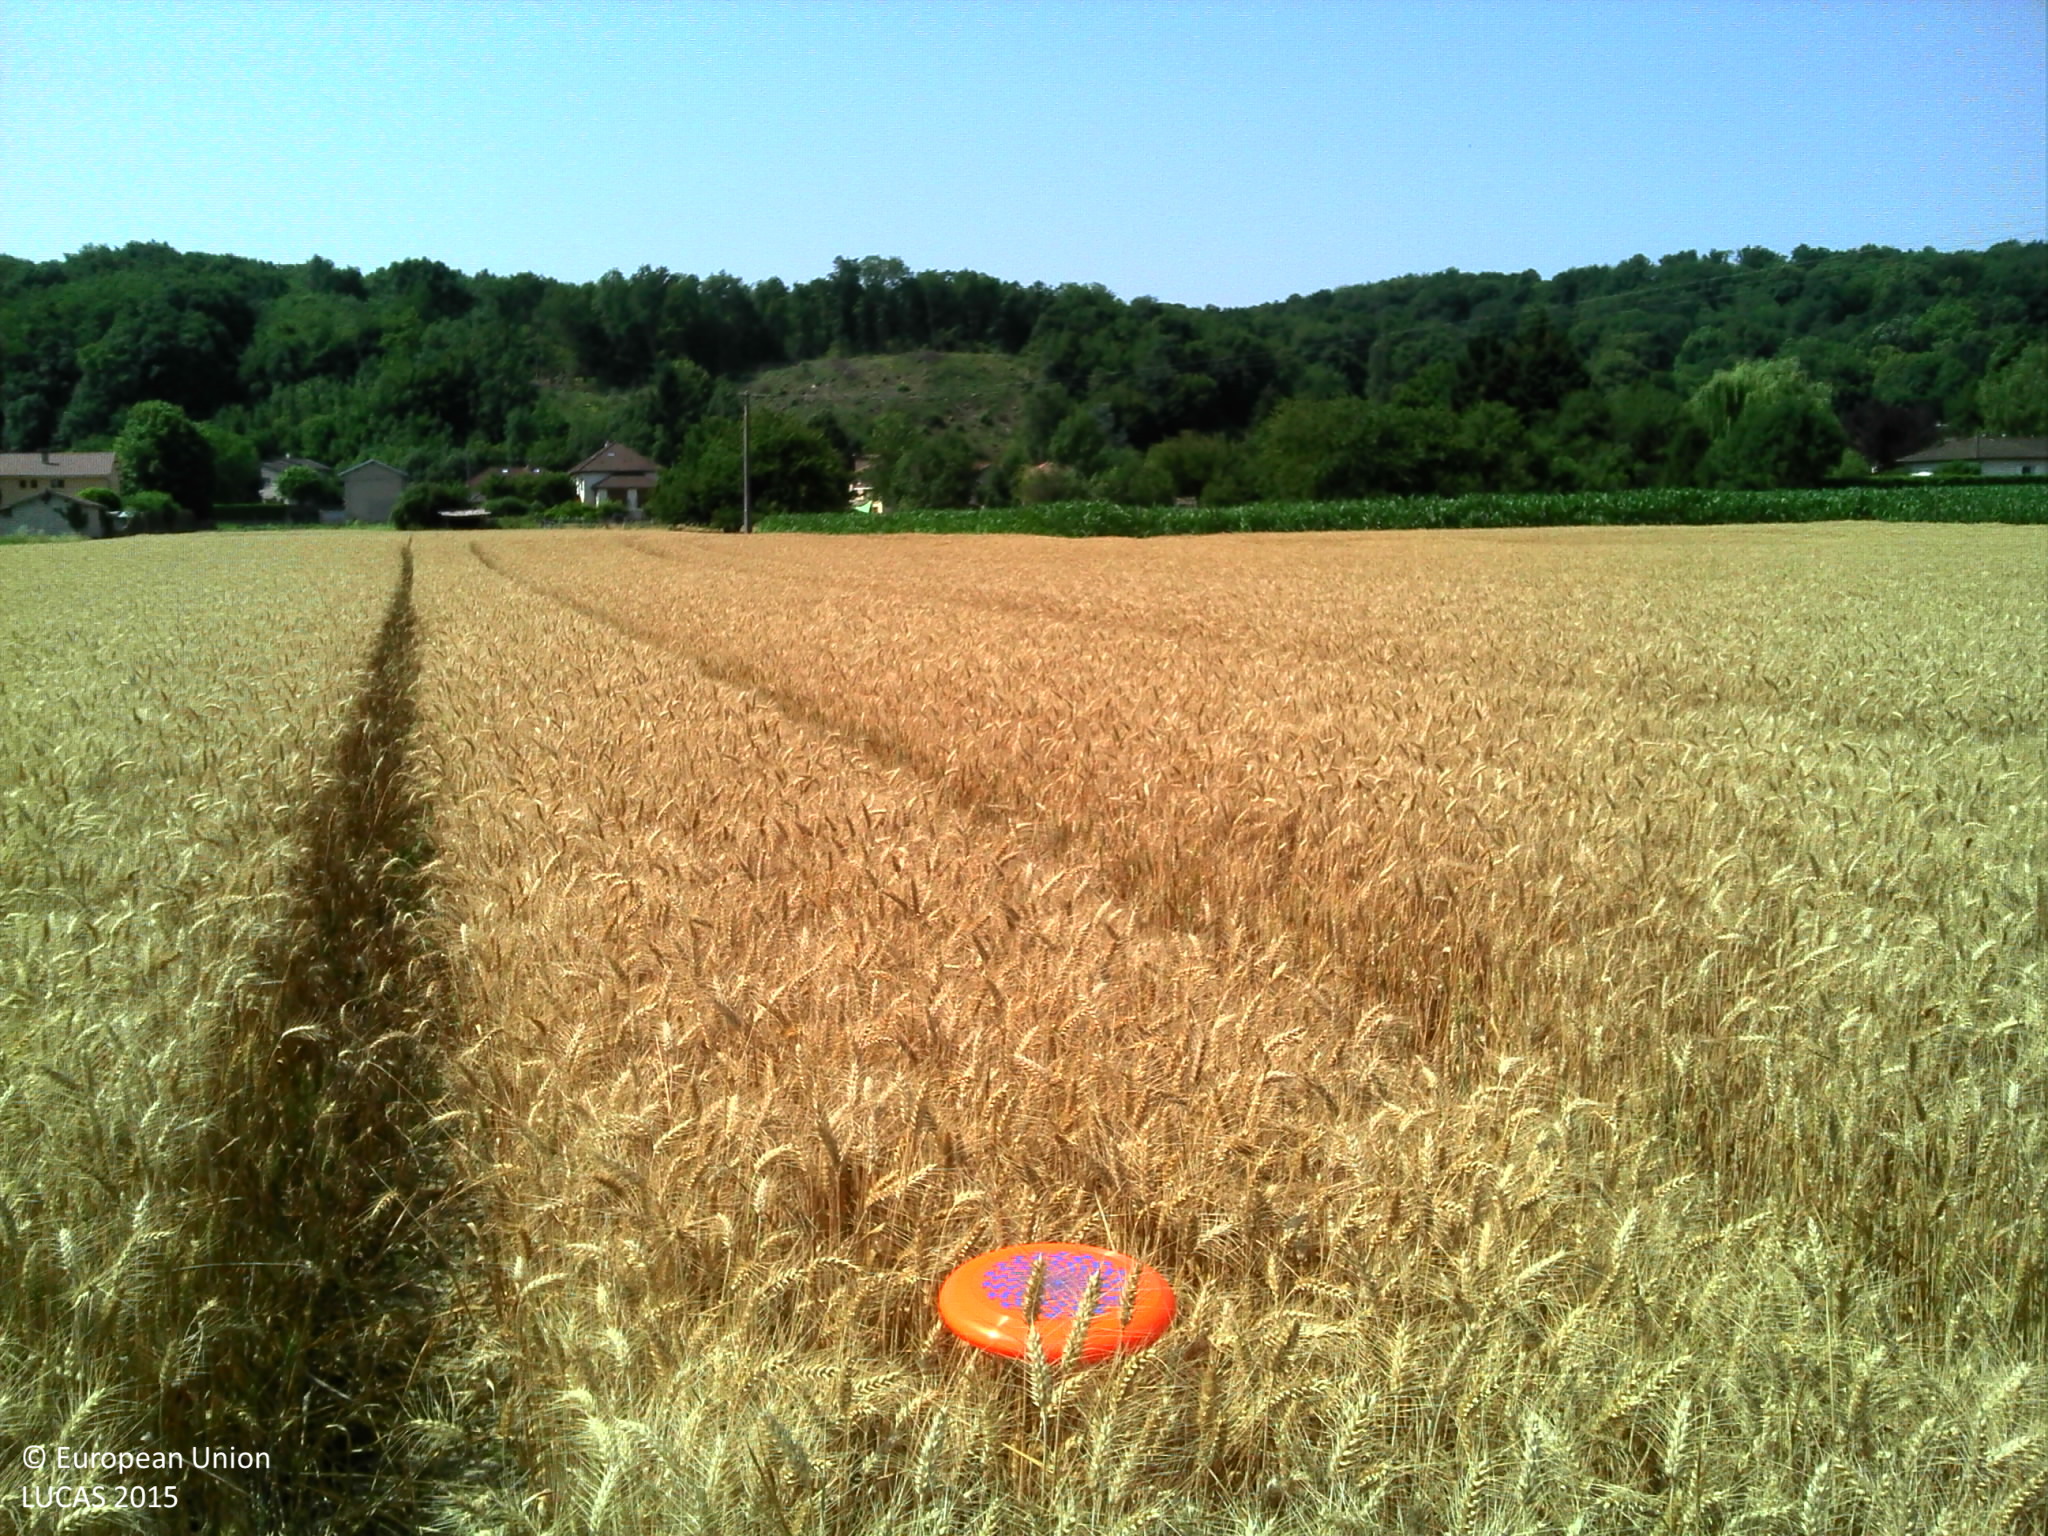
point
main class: Cropland
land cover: Durum wheat
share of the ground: > 75 %
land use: Agriculture (excluding fallow land and kitchen gardens)
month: July
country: FR
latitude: 45.6117
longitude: 5.1956
